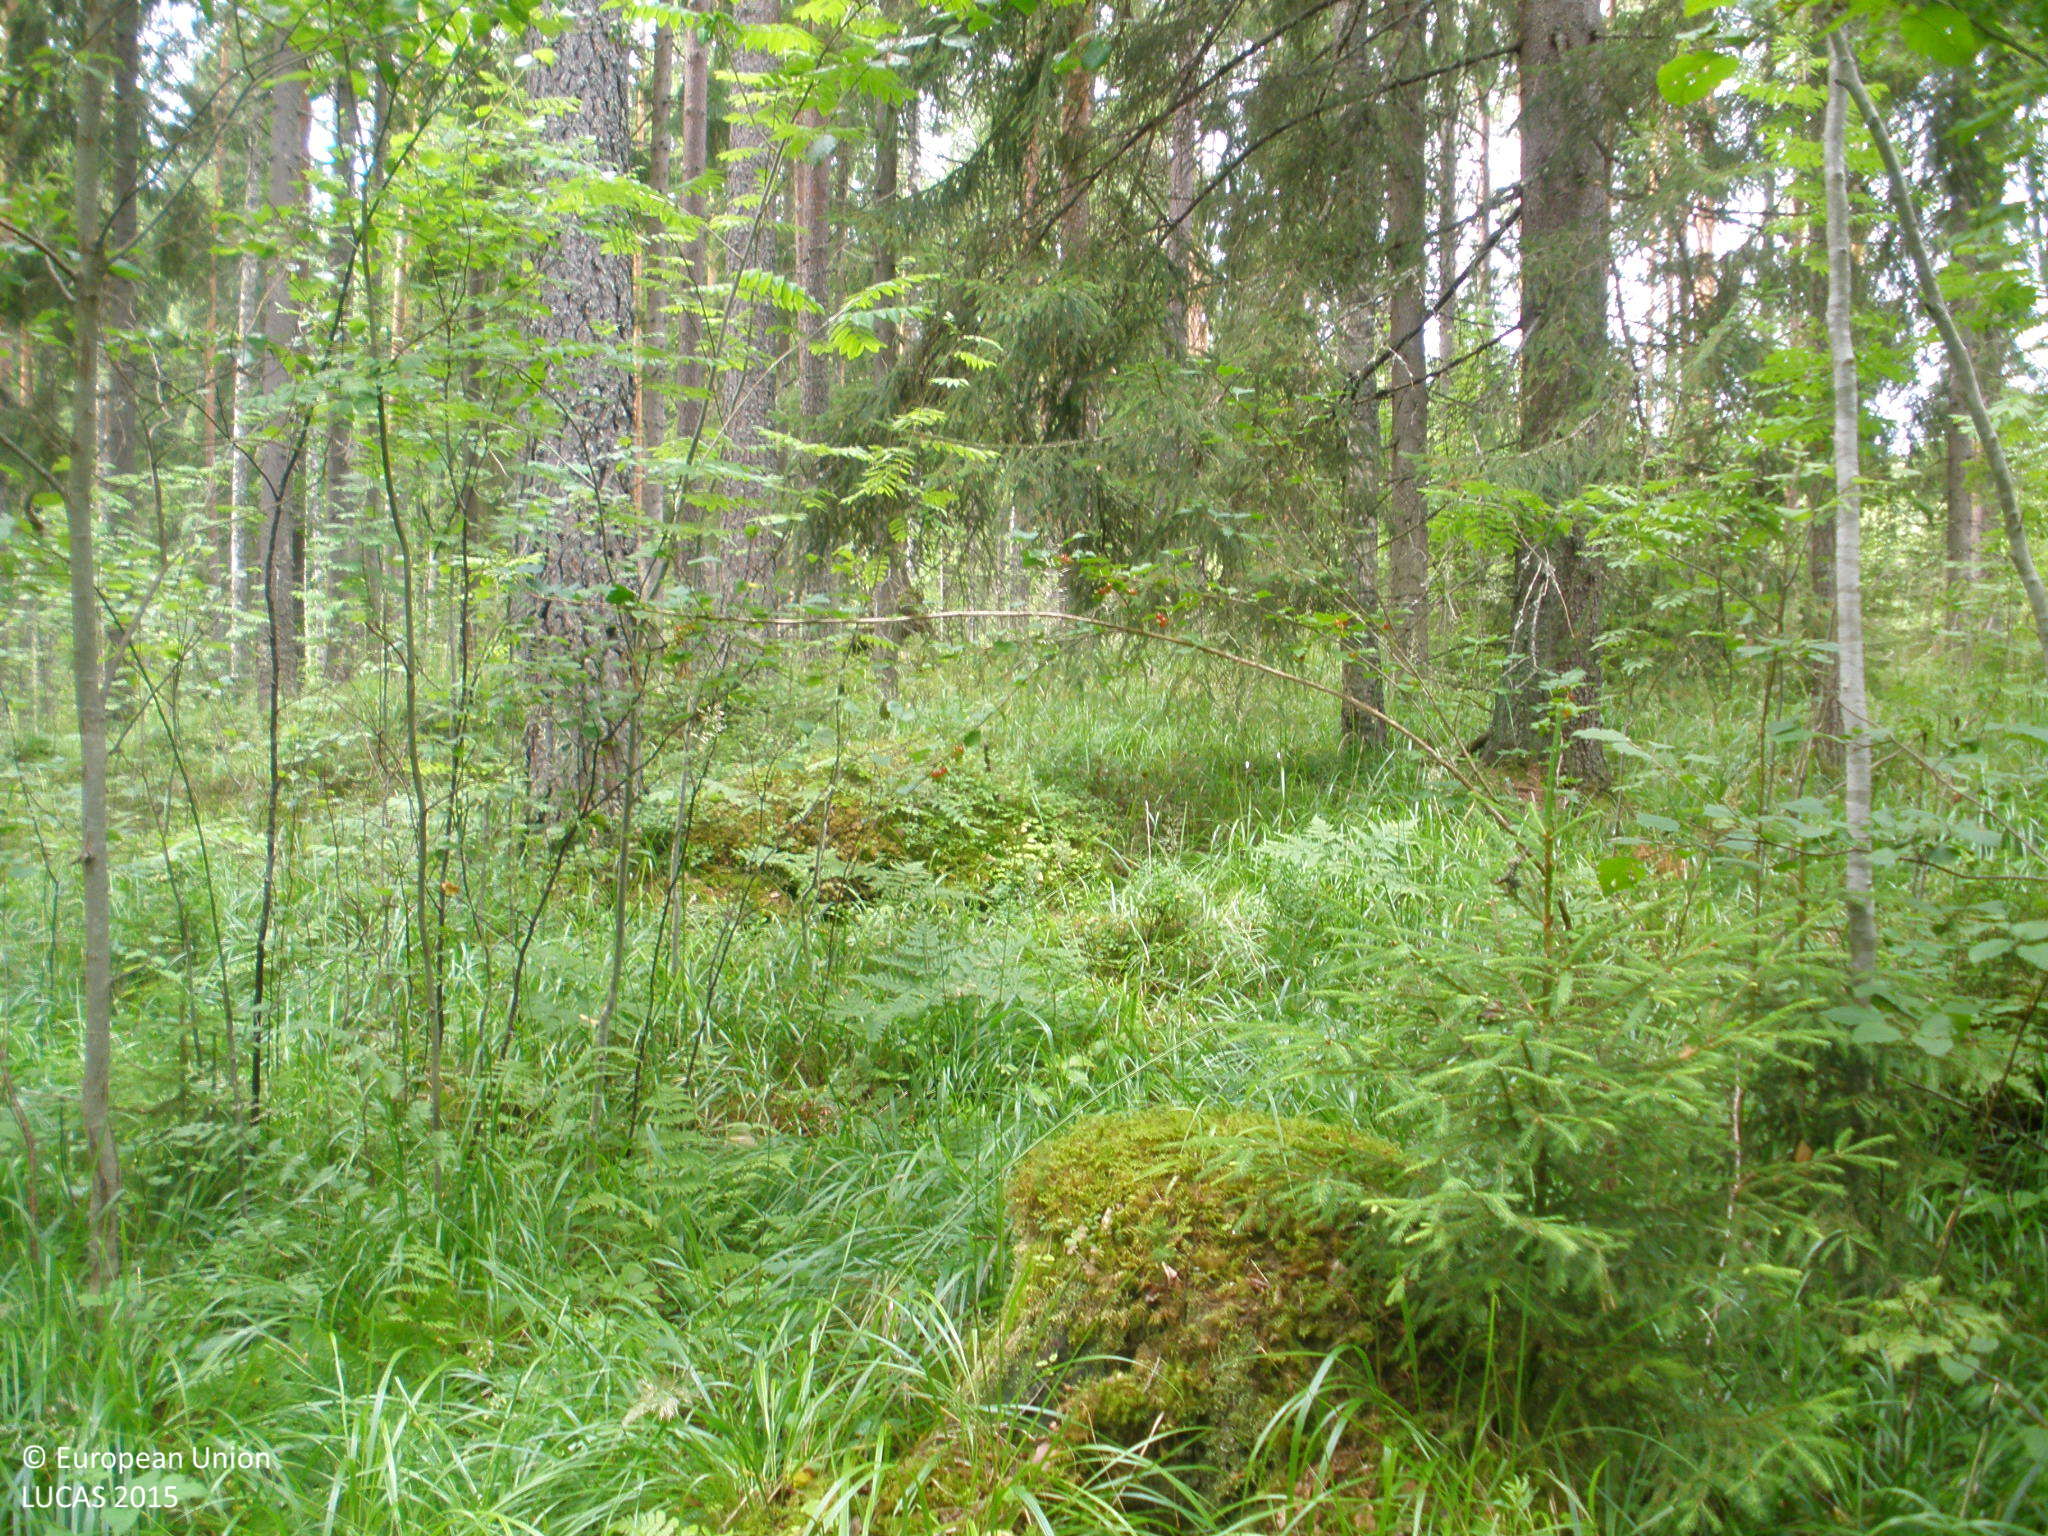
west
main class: Woodland
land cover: Spruce dominated mixed woodland
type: boreal forest
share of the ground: > 75 %
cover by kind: coniferous forest trees 60 %, broadleaved forest trees 25 %, herbaceous plants 10 %, lichens and mosses 5 %
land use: Forestry
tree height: > 5 m
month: July
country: FI
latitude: 61.3686
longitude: 24.7151
